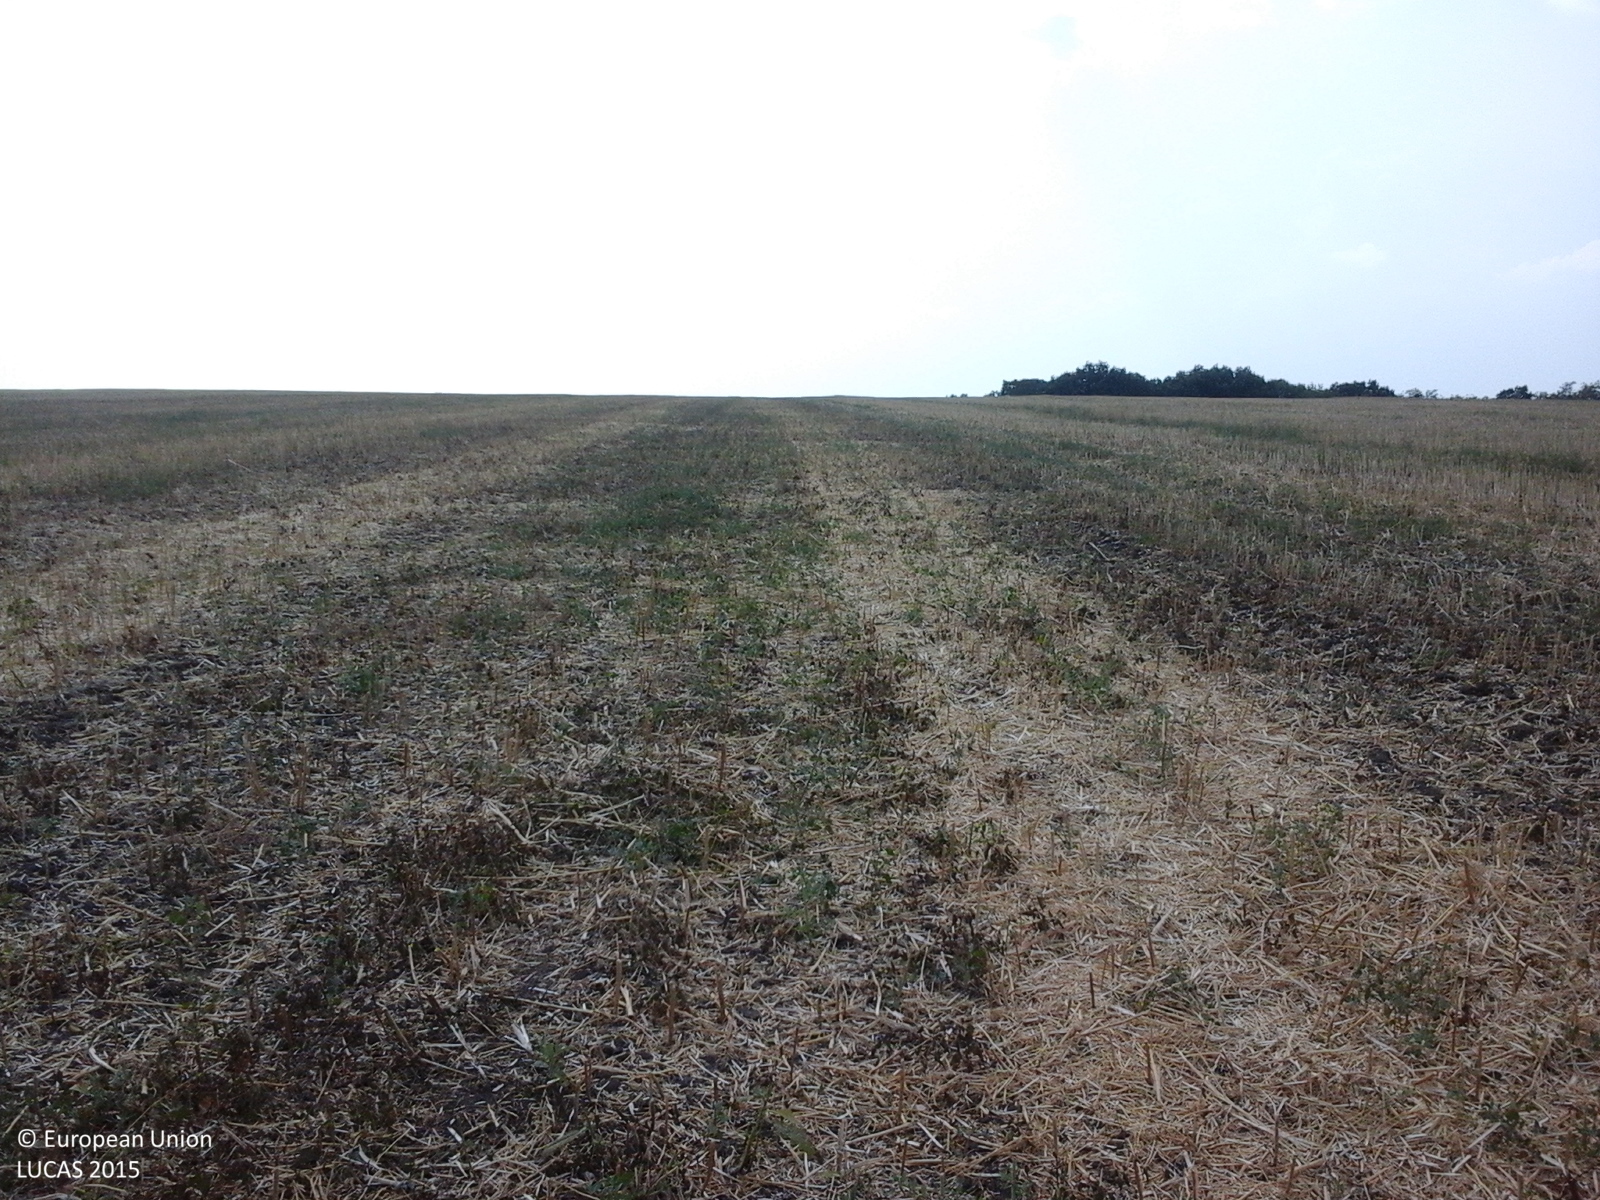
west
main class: Cropland
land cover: Rape and turnip rape
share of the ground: 10 - 25 %
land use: Agriculture (excluding fallow land and kitchen gardens)
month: July
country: RO
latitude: 45.7827
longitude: 27.9057
